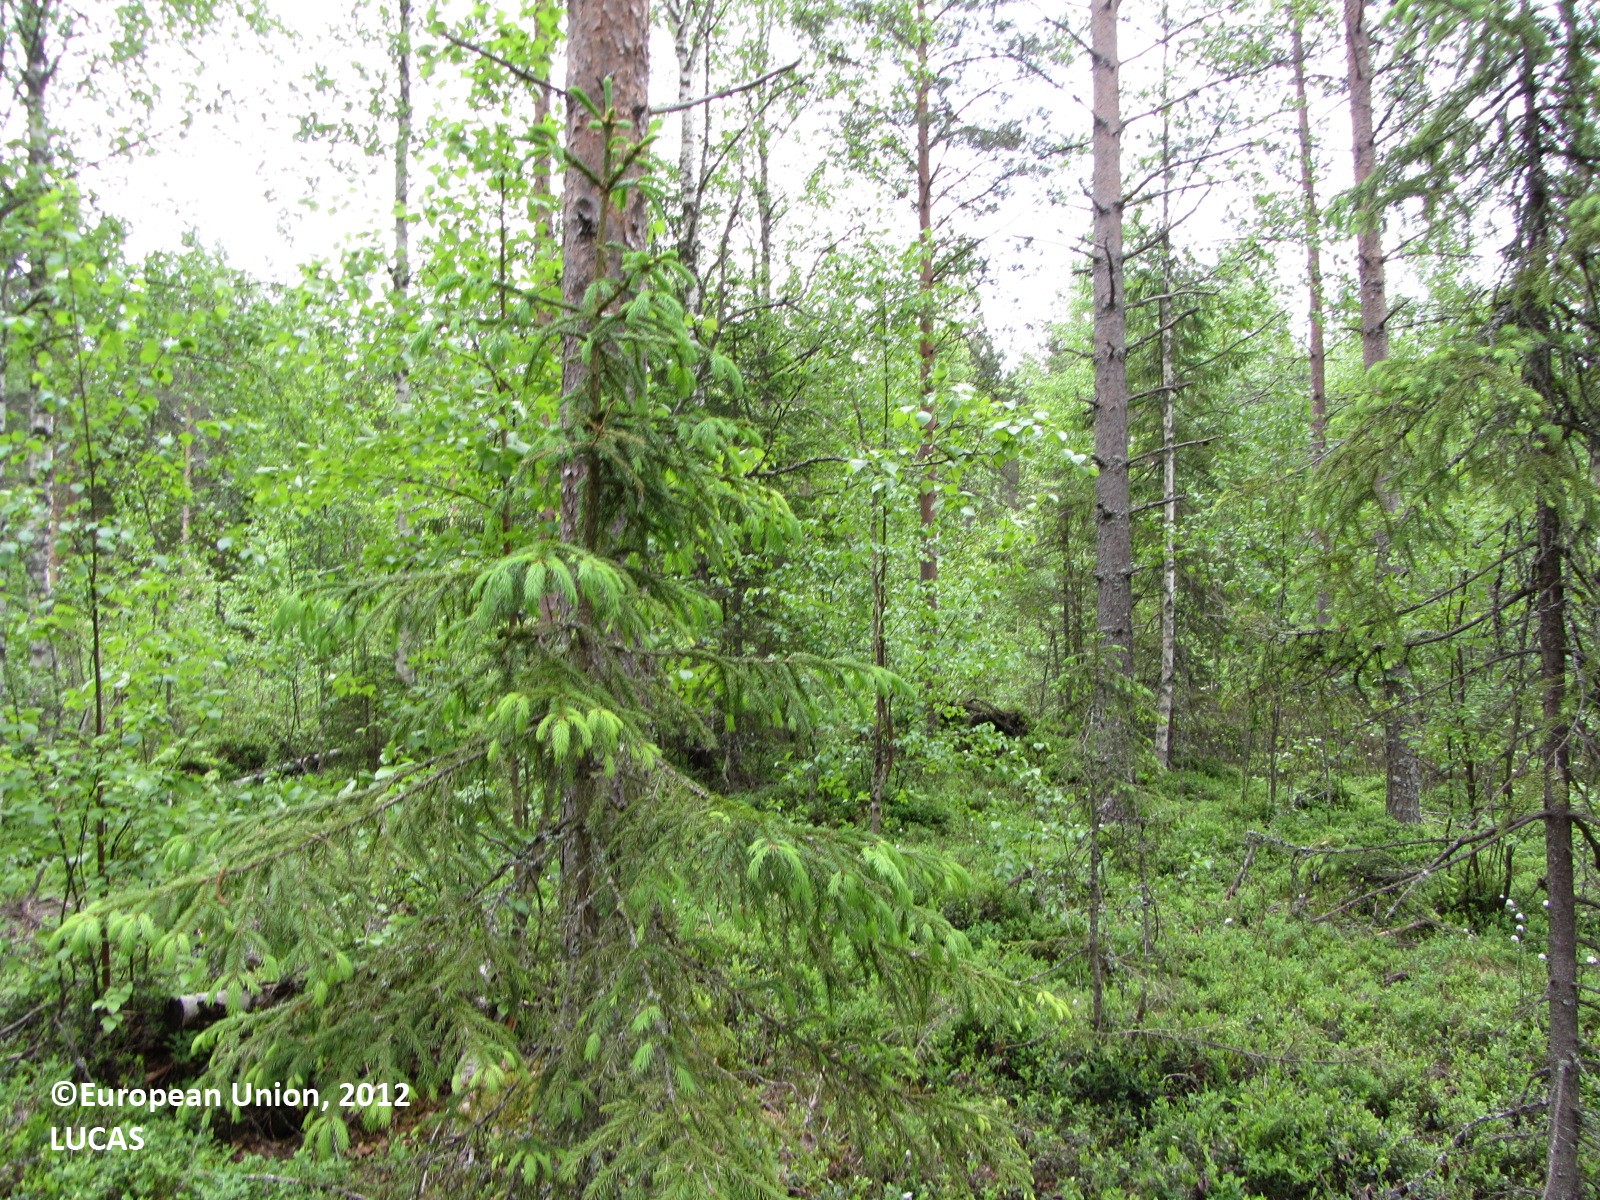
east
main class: Woodland
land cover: Other mixed woodland
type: boreal forest
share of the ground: 50 - 75 %
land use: Forestry
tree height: > 5 m
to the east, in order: Other mixed woodland; Pine dominated mixed woodland; Ditches and canals; Abandoned hedges; Paved roads, cycling and walking lanes; Abandoned hedges; Ditches and canals; Other mixed woodland; Ditches and canals; Other mixed woodland; Ditches and canals; Other coniferous woodland; Pine dominated mixed woodland; Shrubland with sparse tree cover; Pine dominated mixed woodland; Other mixed woodland; Rivers and streams; Broadleaved woodland; Electric lines
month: June
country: FI
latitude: 62.4286
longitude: 25.1520
